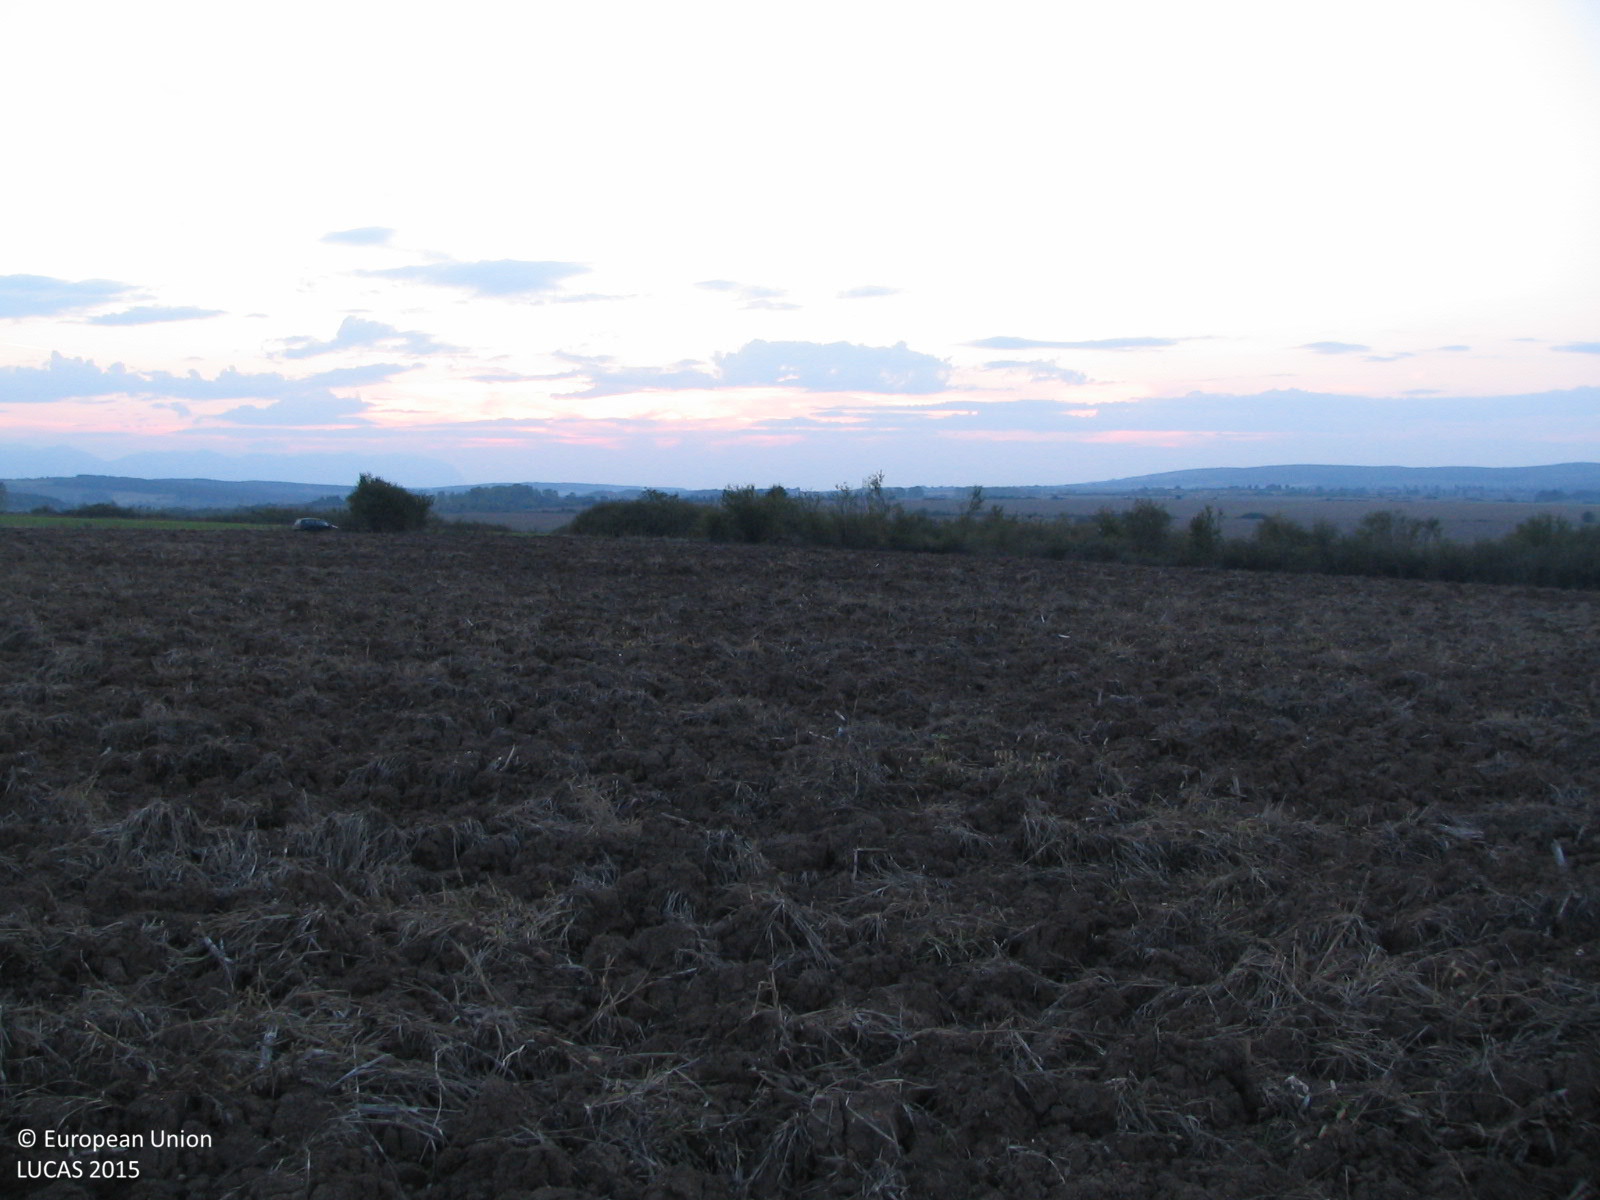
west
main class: Cropland
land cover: Maize
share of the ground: < 10 %
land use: Agriculture (excluding fallow land and kitchen gardens)
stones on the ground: < 10 %
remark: Harvested field
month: October
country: BG
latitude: 43.3033
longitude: 23.7425
